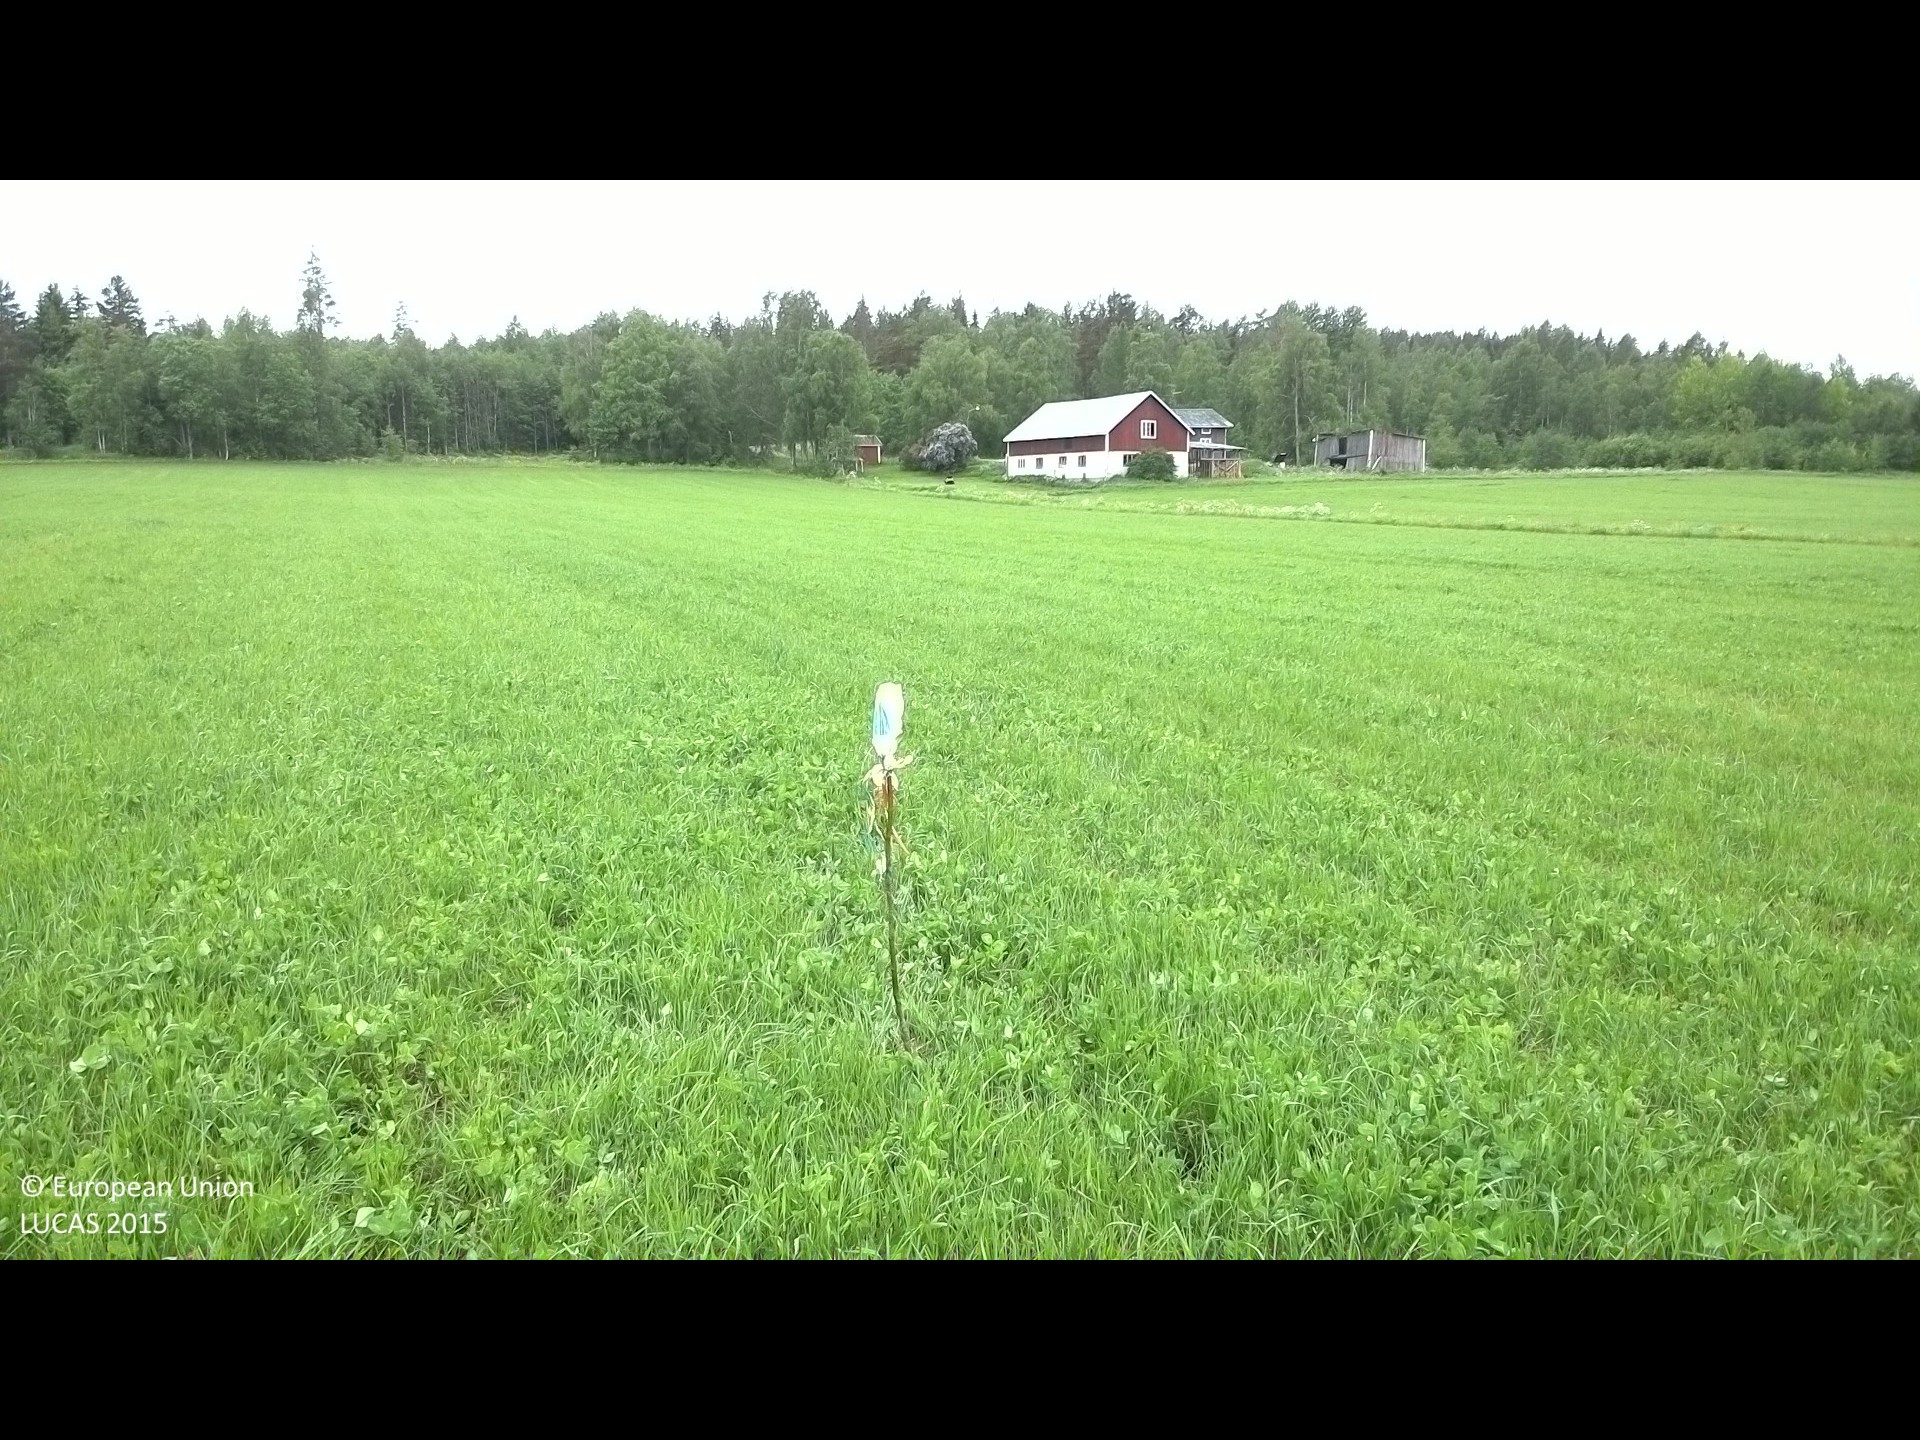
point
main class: Cropland
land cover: Other leguminous and mixtures for fodder
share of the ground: > 75 %
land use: Agriculture (excluding fallow land and kitchen gardens)
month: June
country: SE
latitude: 61.9920
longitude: 17.1025
